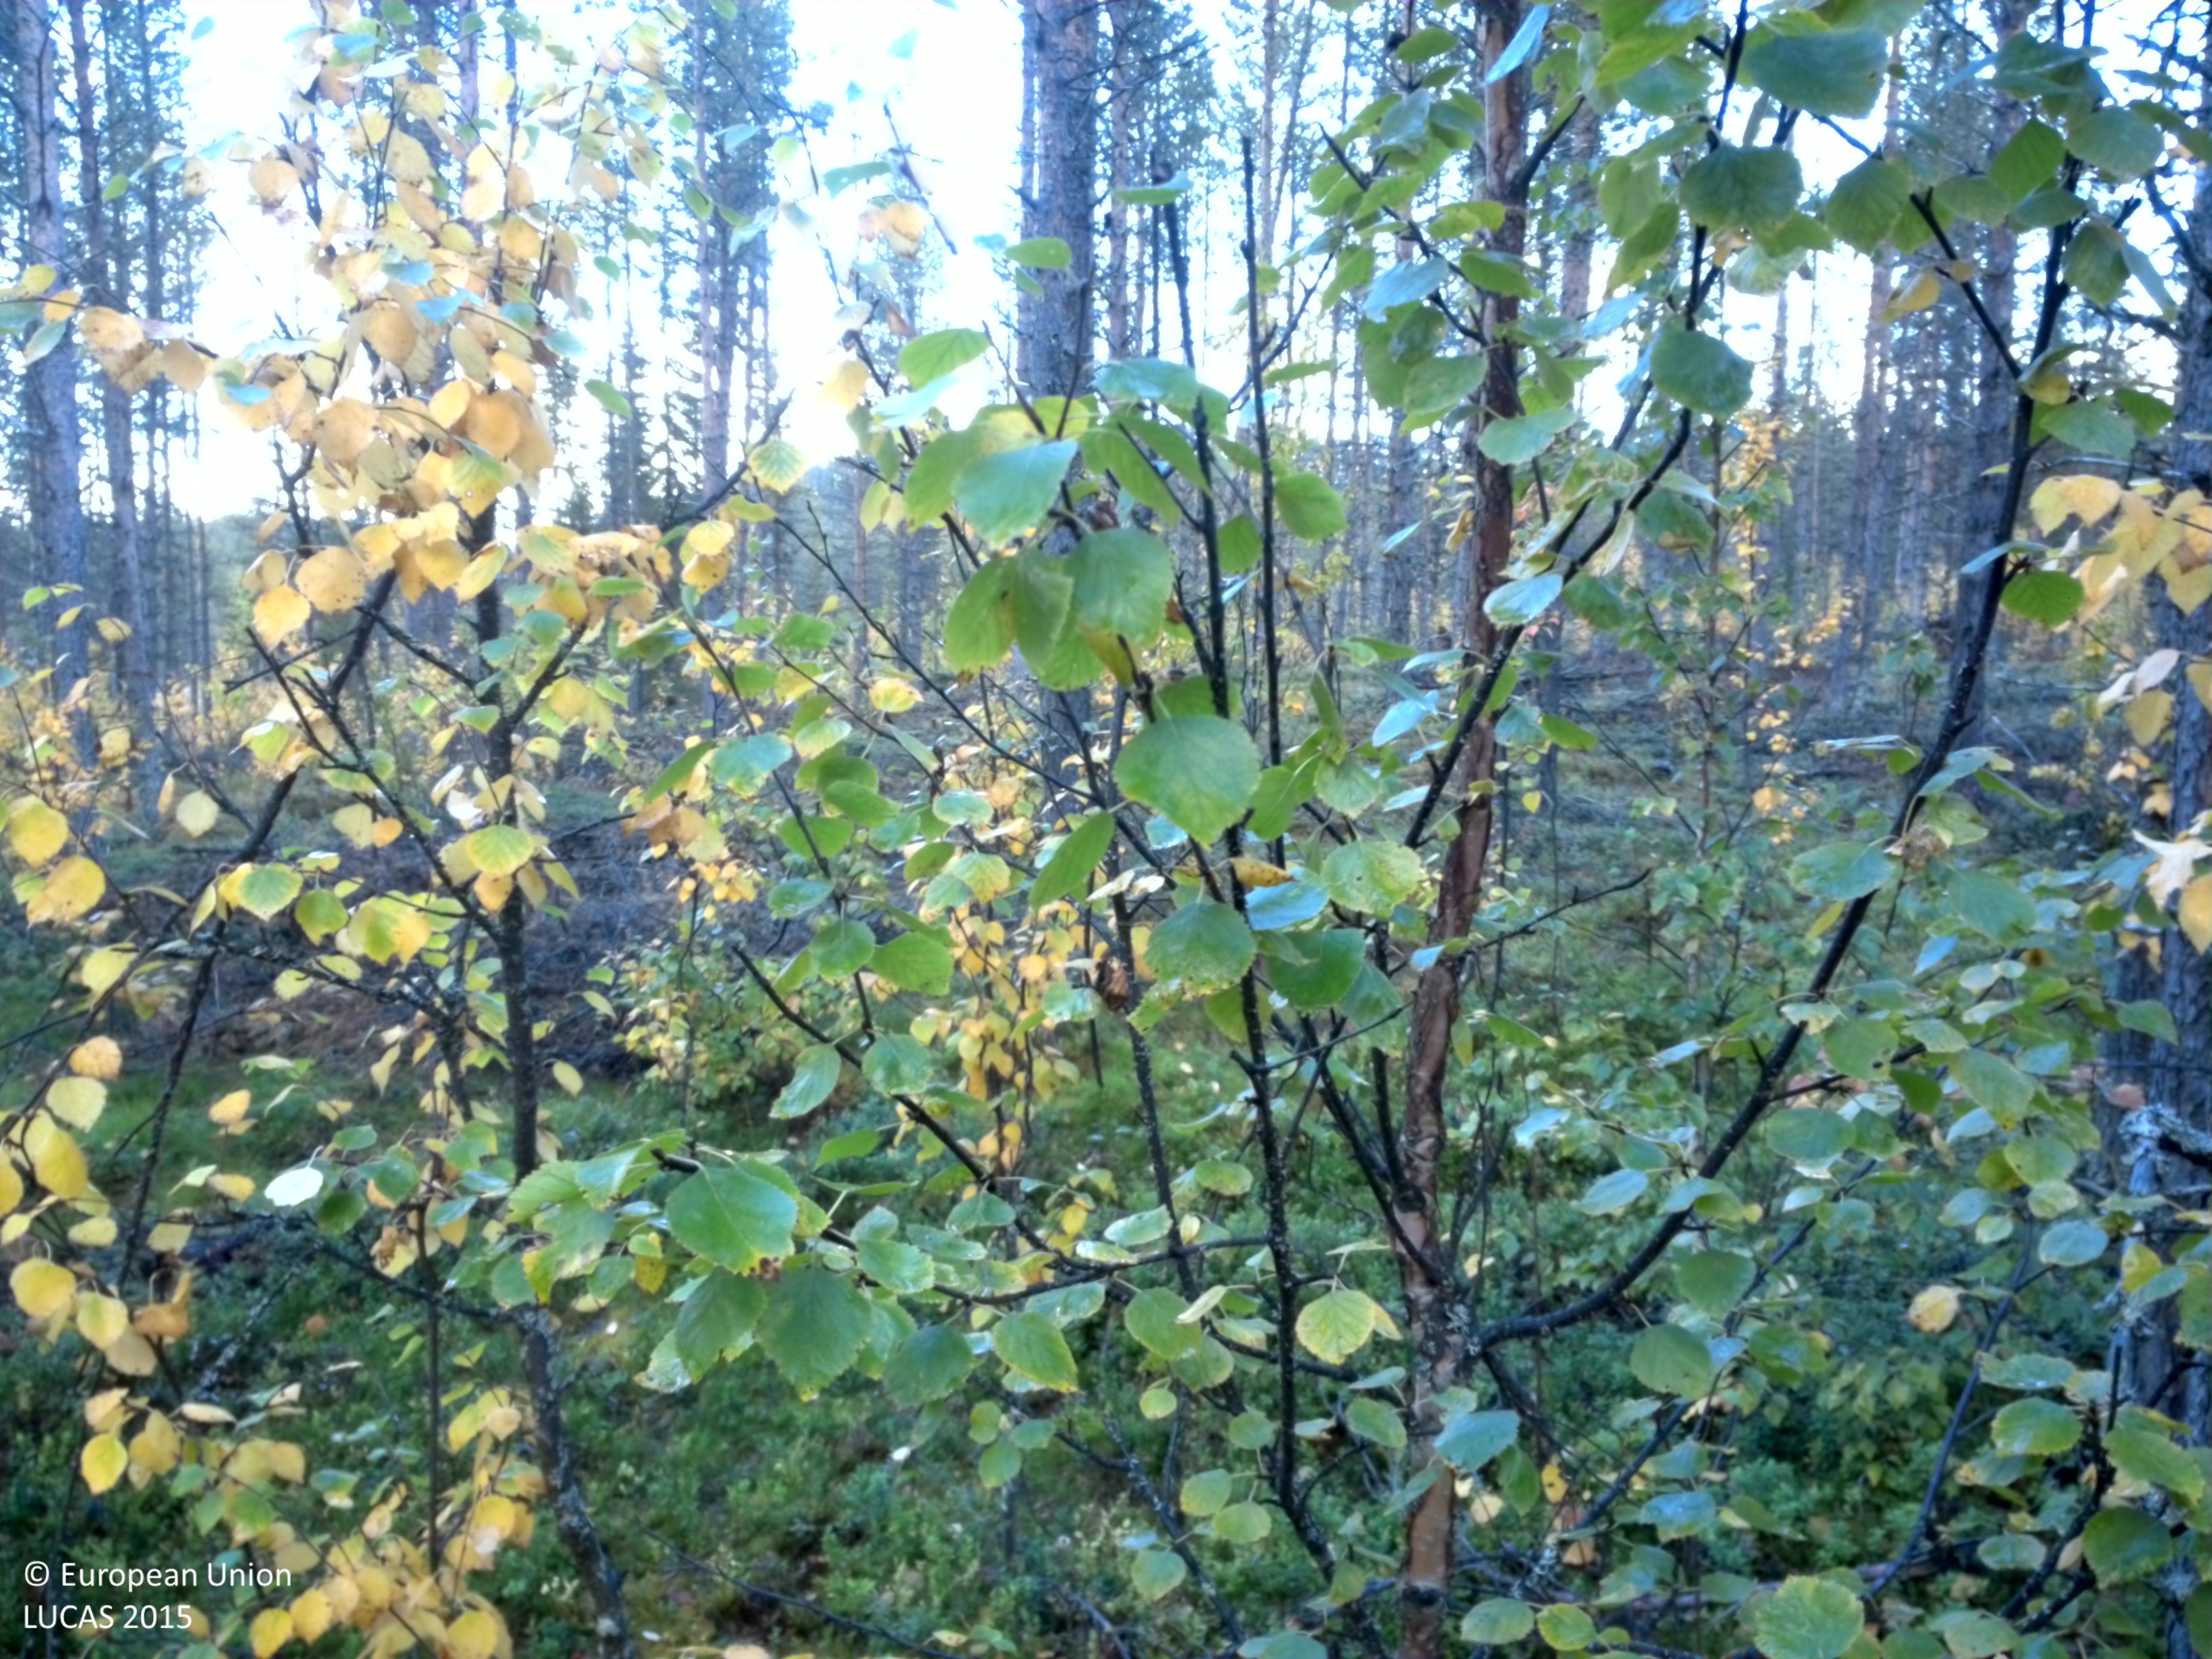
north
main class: Woodland
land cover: Pine dominated mixed woodland
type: boreal forest
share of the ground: 25 - 50 %
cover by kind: shrubs 35 %, coniferous forest trees 25 %, lichens and mosses 15 %, broadleaved forest trees 10 %, herbaceous plants 10 %
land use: Forestry
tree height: > 5 m
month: September
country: SE
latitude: 65.2232
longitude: 16.5711
